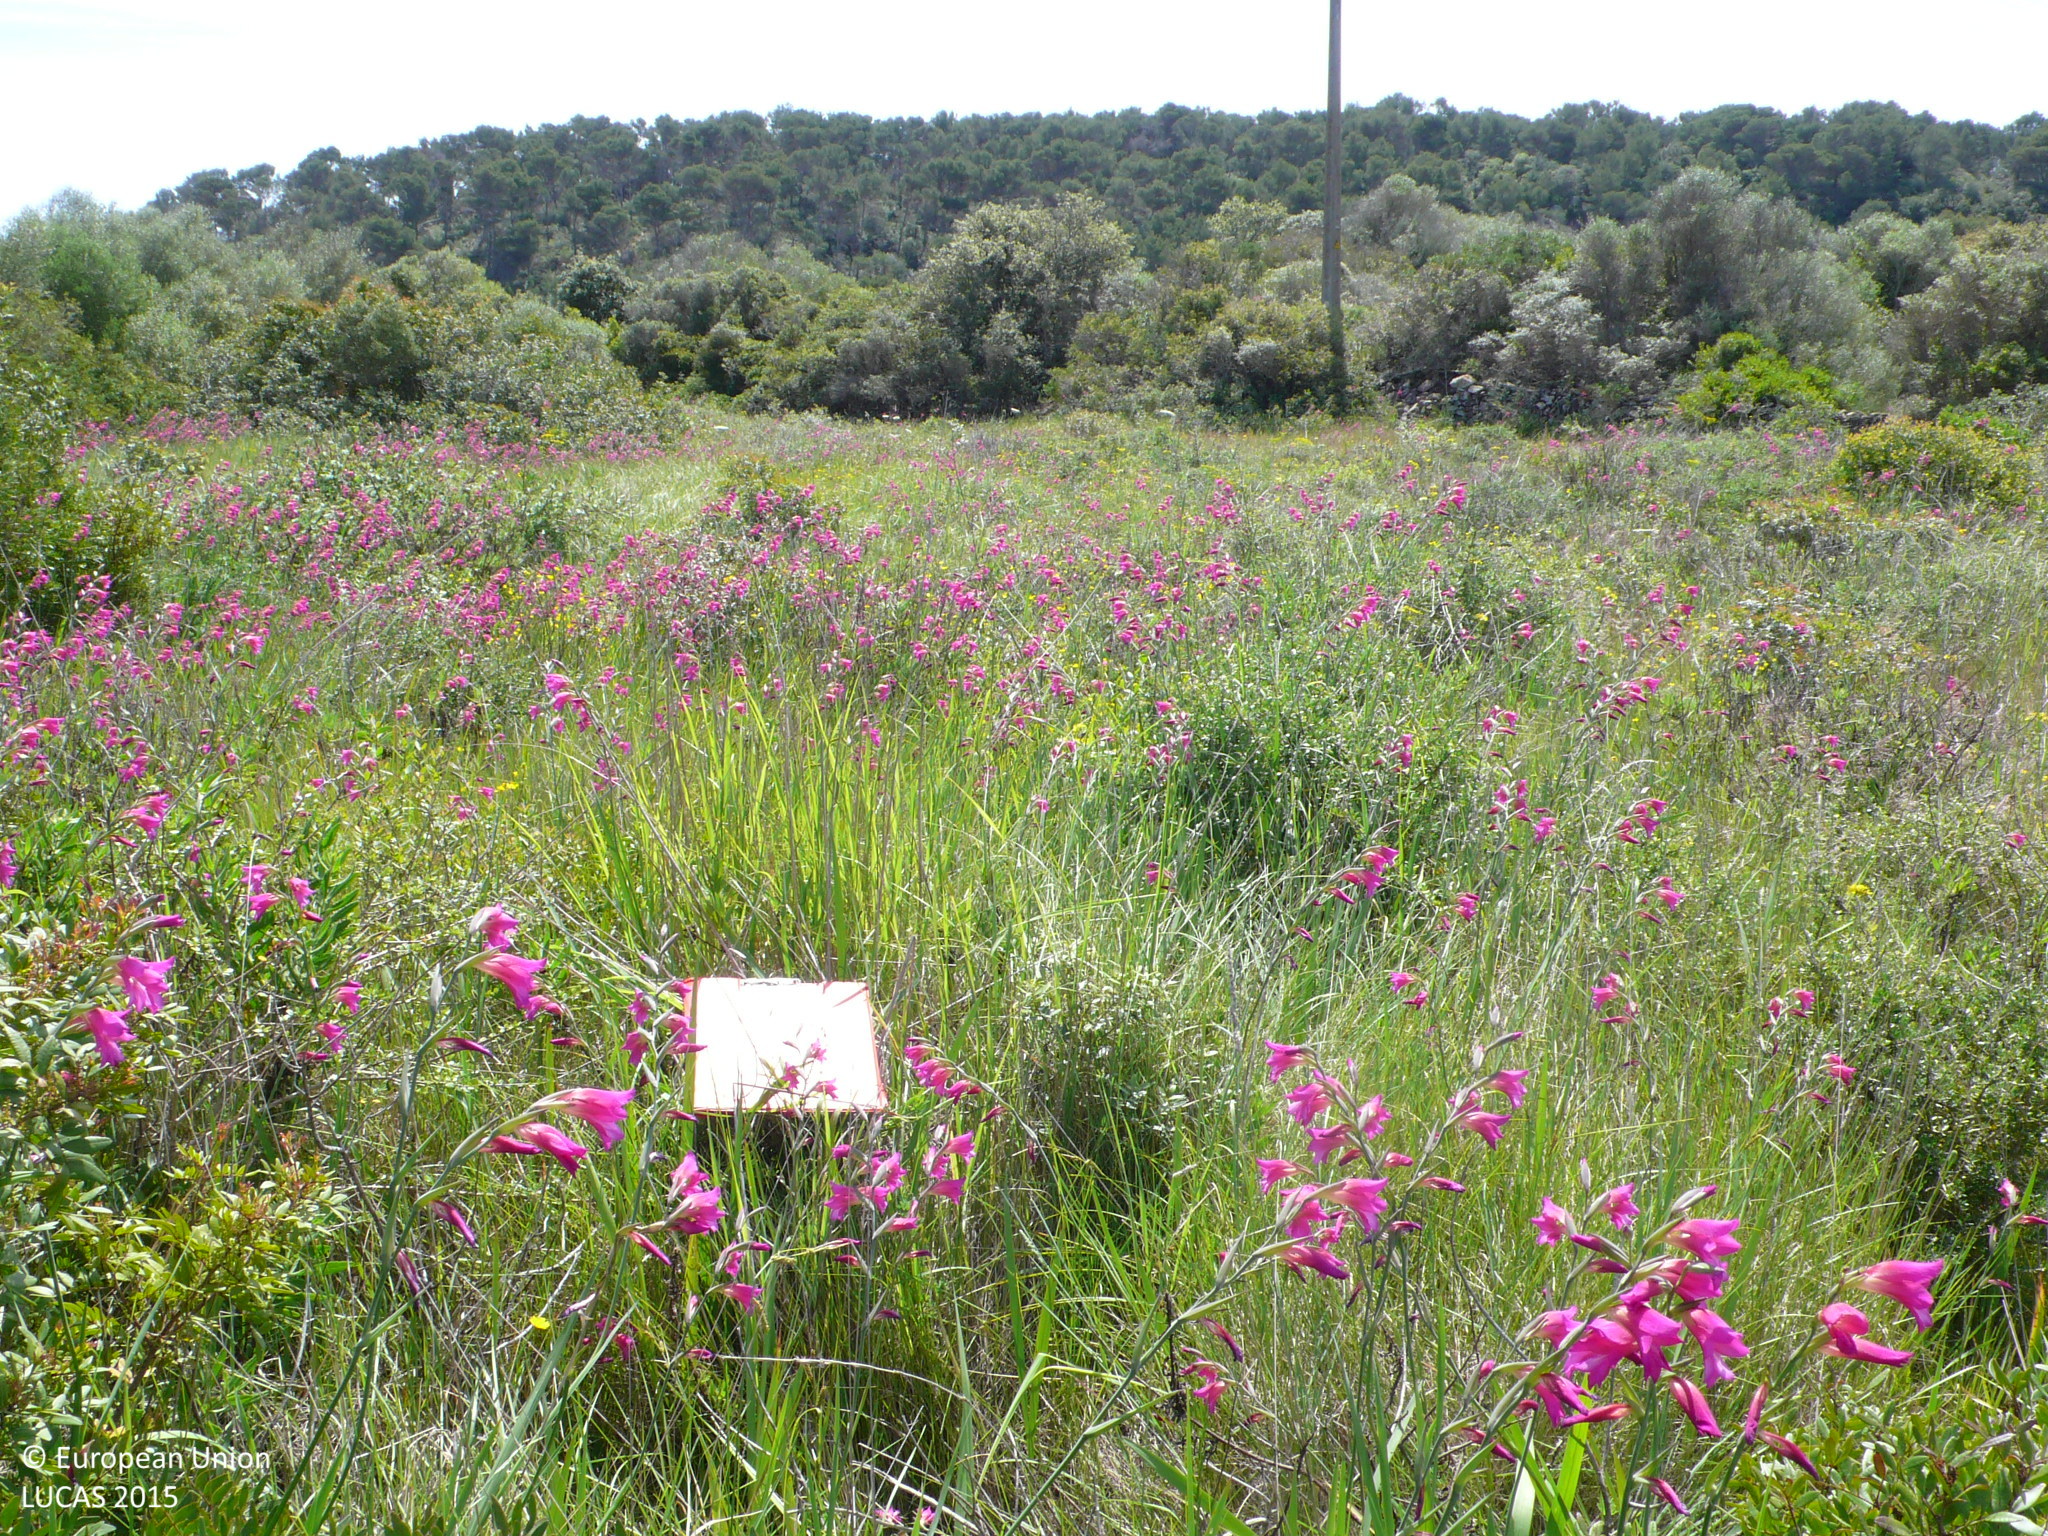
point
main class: Shrubland
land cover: Shrubland with sparse tree cover
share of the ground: 50 - 75 %
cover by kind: shrubs 55 %, herbaceous plants 40 %, broadleaved forest trees 5 %
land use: Semi-natural and natural areas not in use
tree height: < 5 m
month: May
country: ES
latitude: 40.0038
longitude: 4.1804
